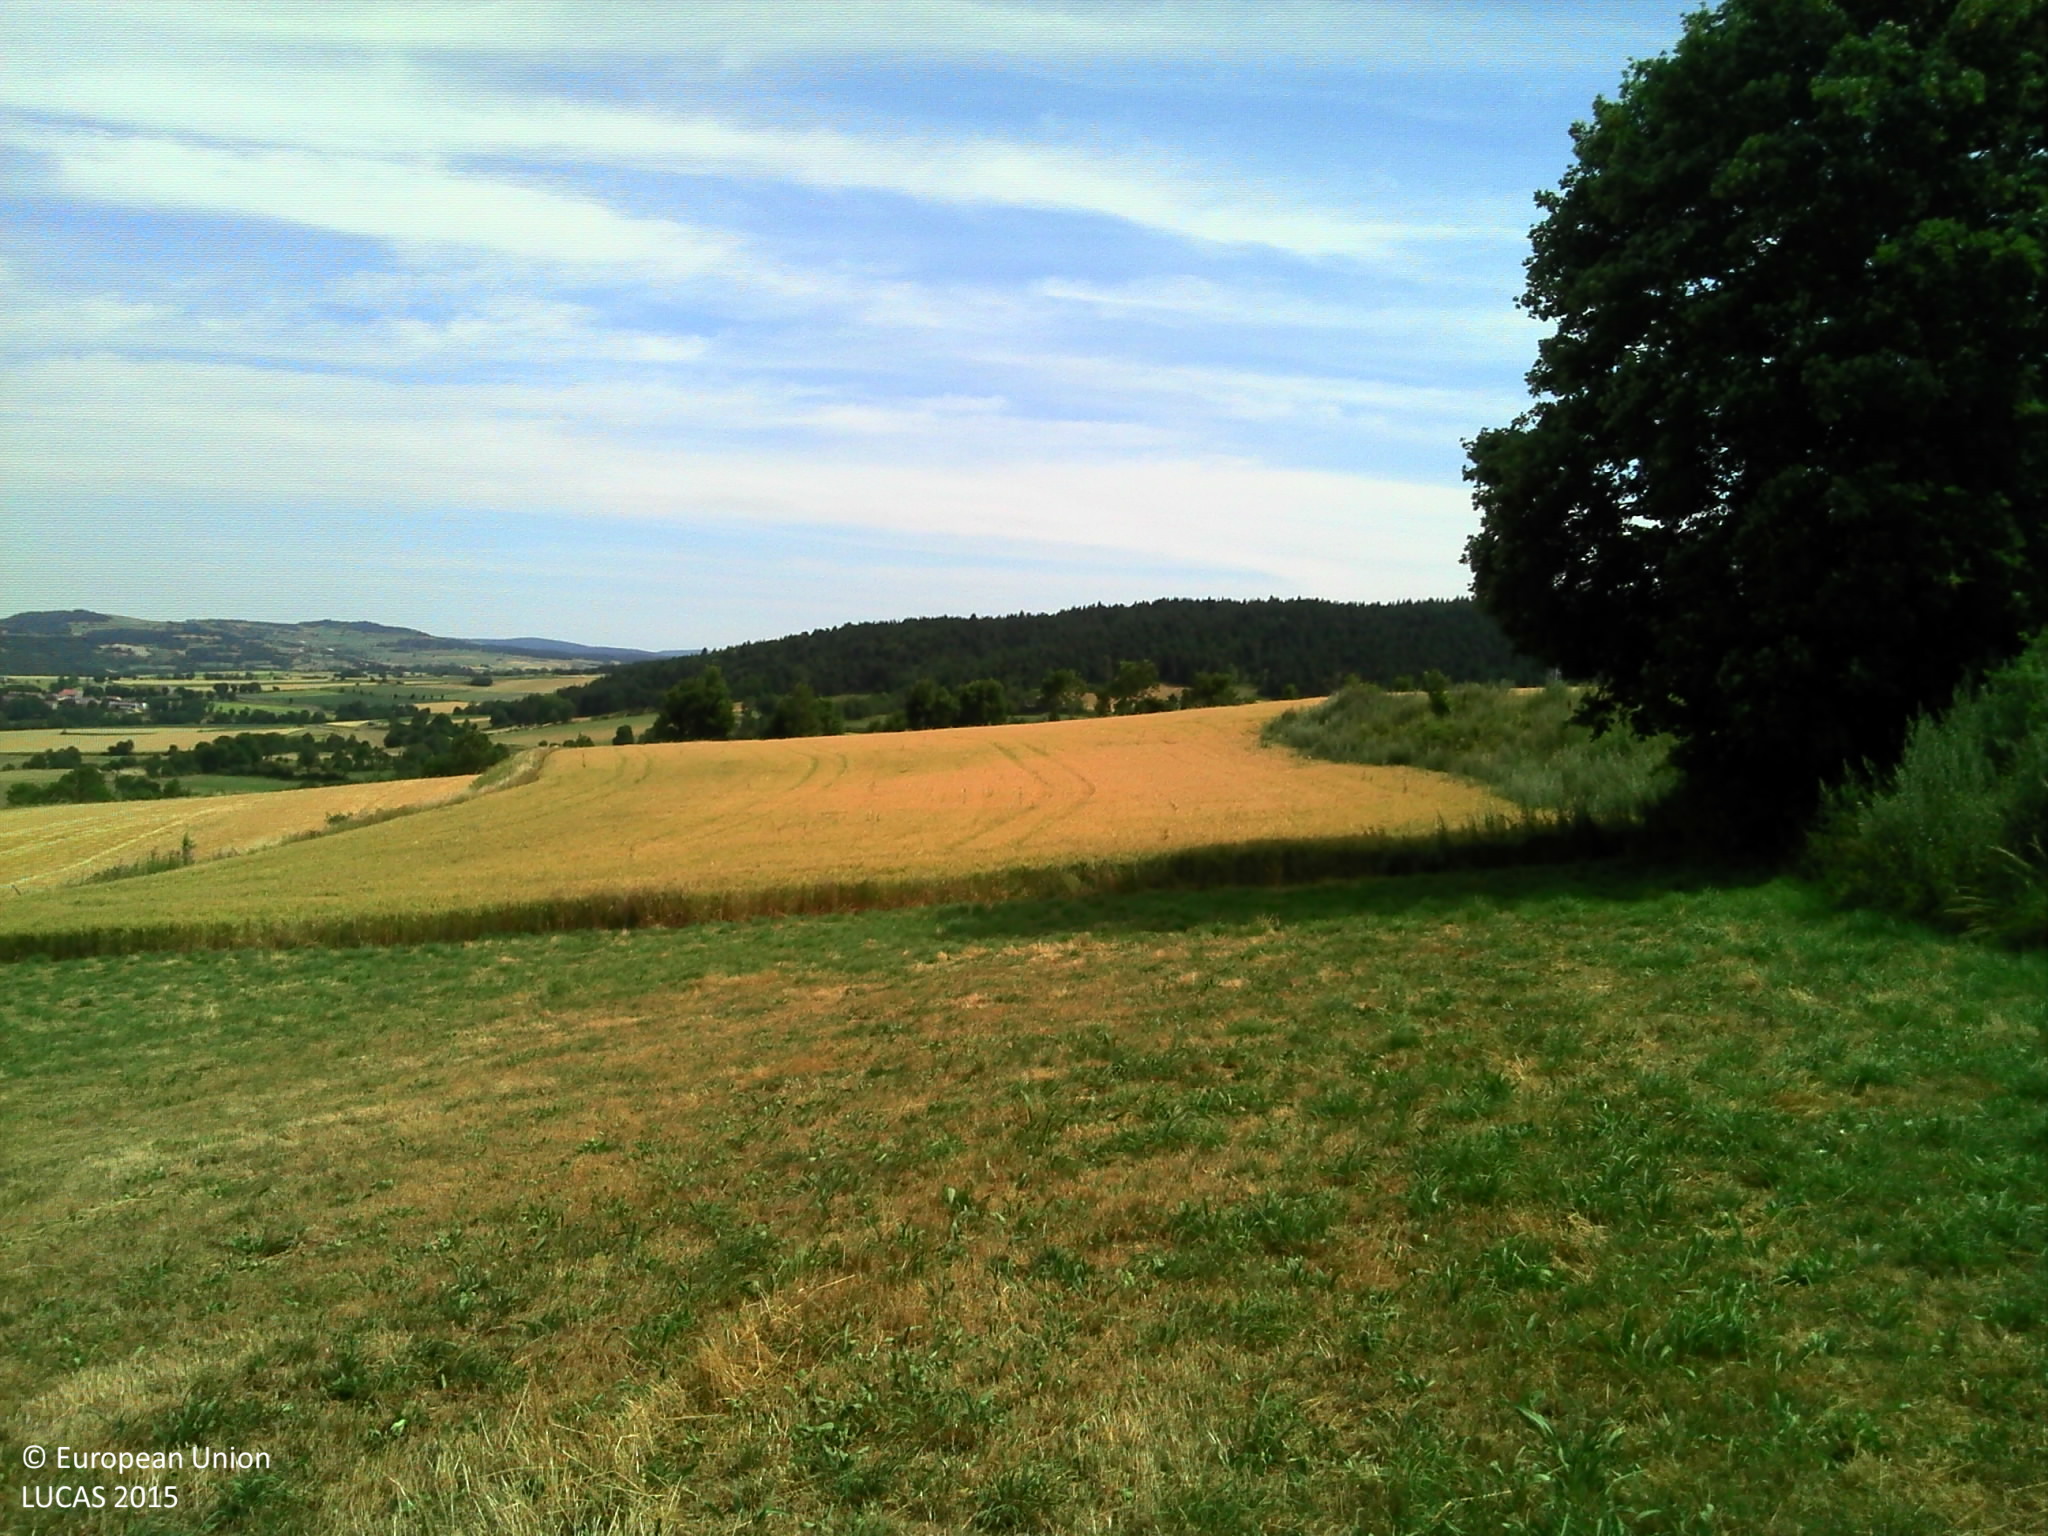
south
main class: Grassland
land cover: Grassland without tree/shrub cover
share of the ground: > 75 %
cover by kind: herbaceous plants 100 %
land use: Agriculture (excluding fallow land and kitchen gardens)
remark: Harvested field
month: July
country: FR
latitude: 44.8397
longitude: 3.8946
